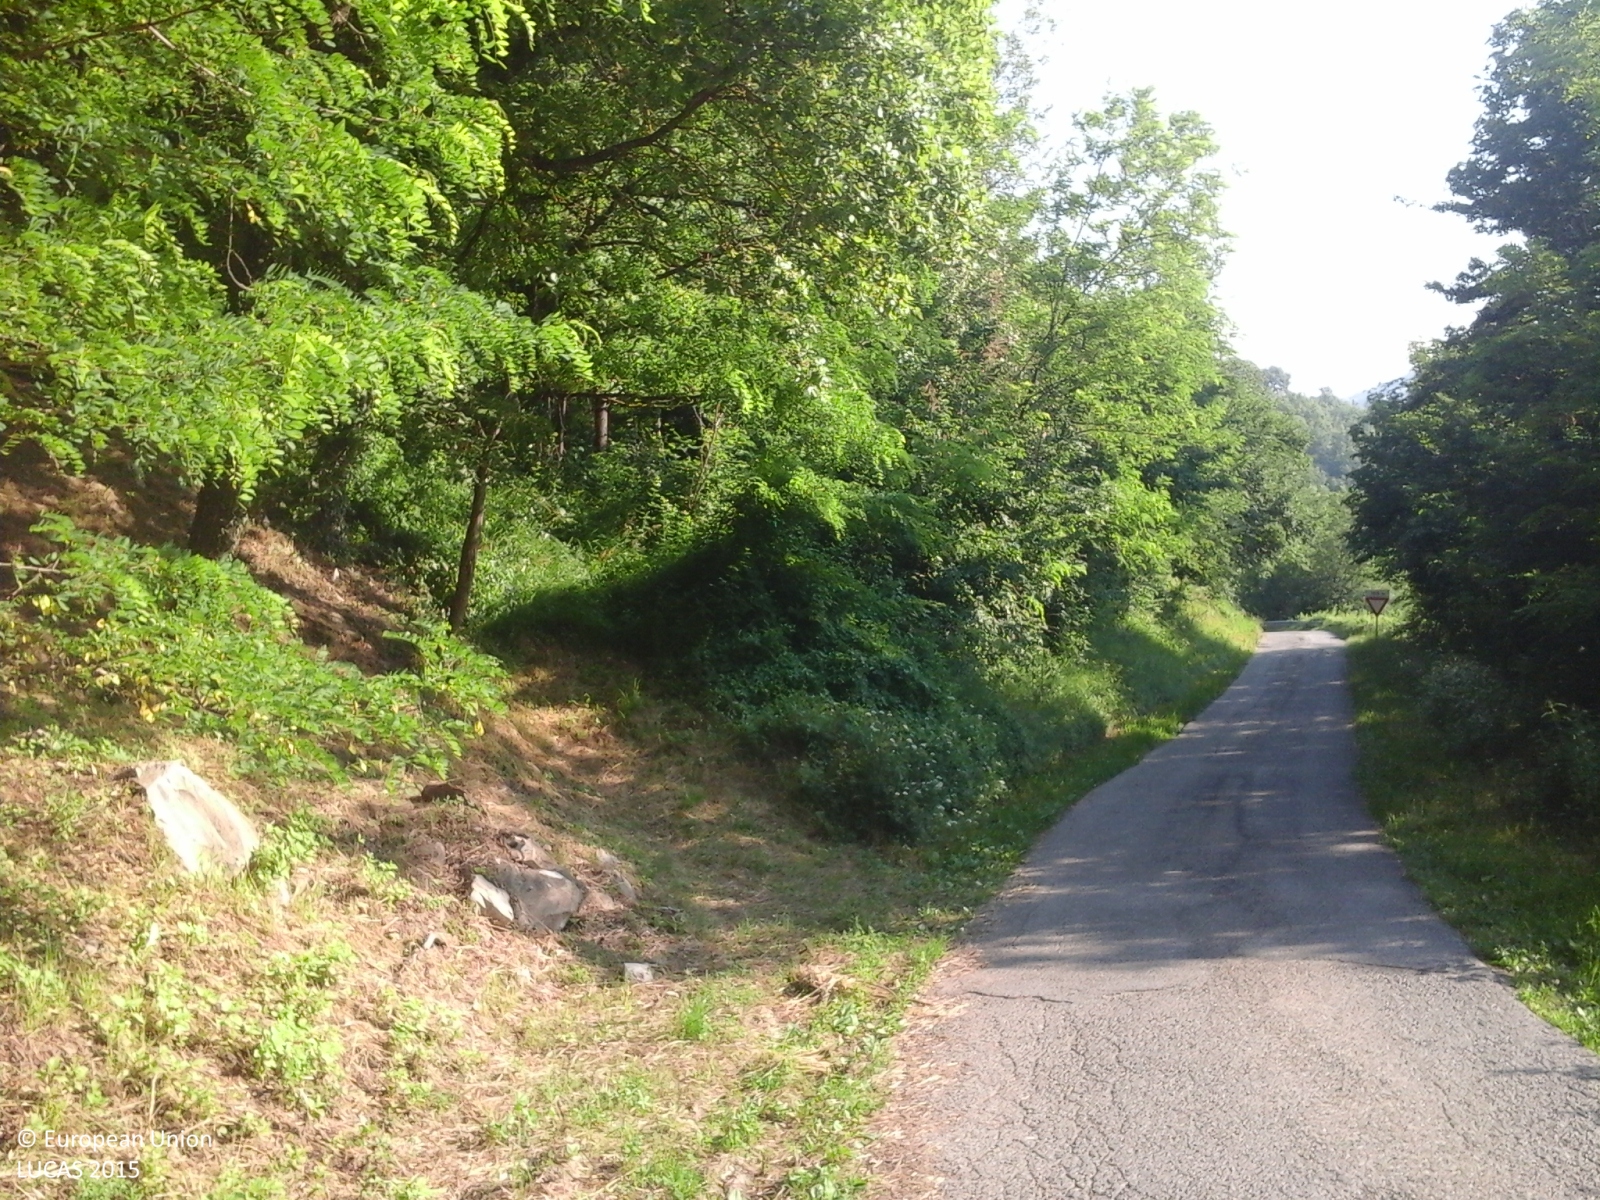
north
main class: Woodland
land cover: Broadleaved woodland
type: thermophilous deciduous forest
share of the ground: > 75 %
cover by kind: broadleaved forest trees 100 %
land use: Forestry
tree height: > 5 m
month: June
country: IT
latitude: 44.3848
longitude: 10.6136
